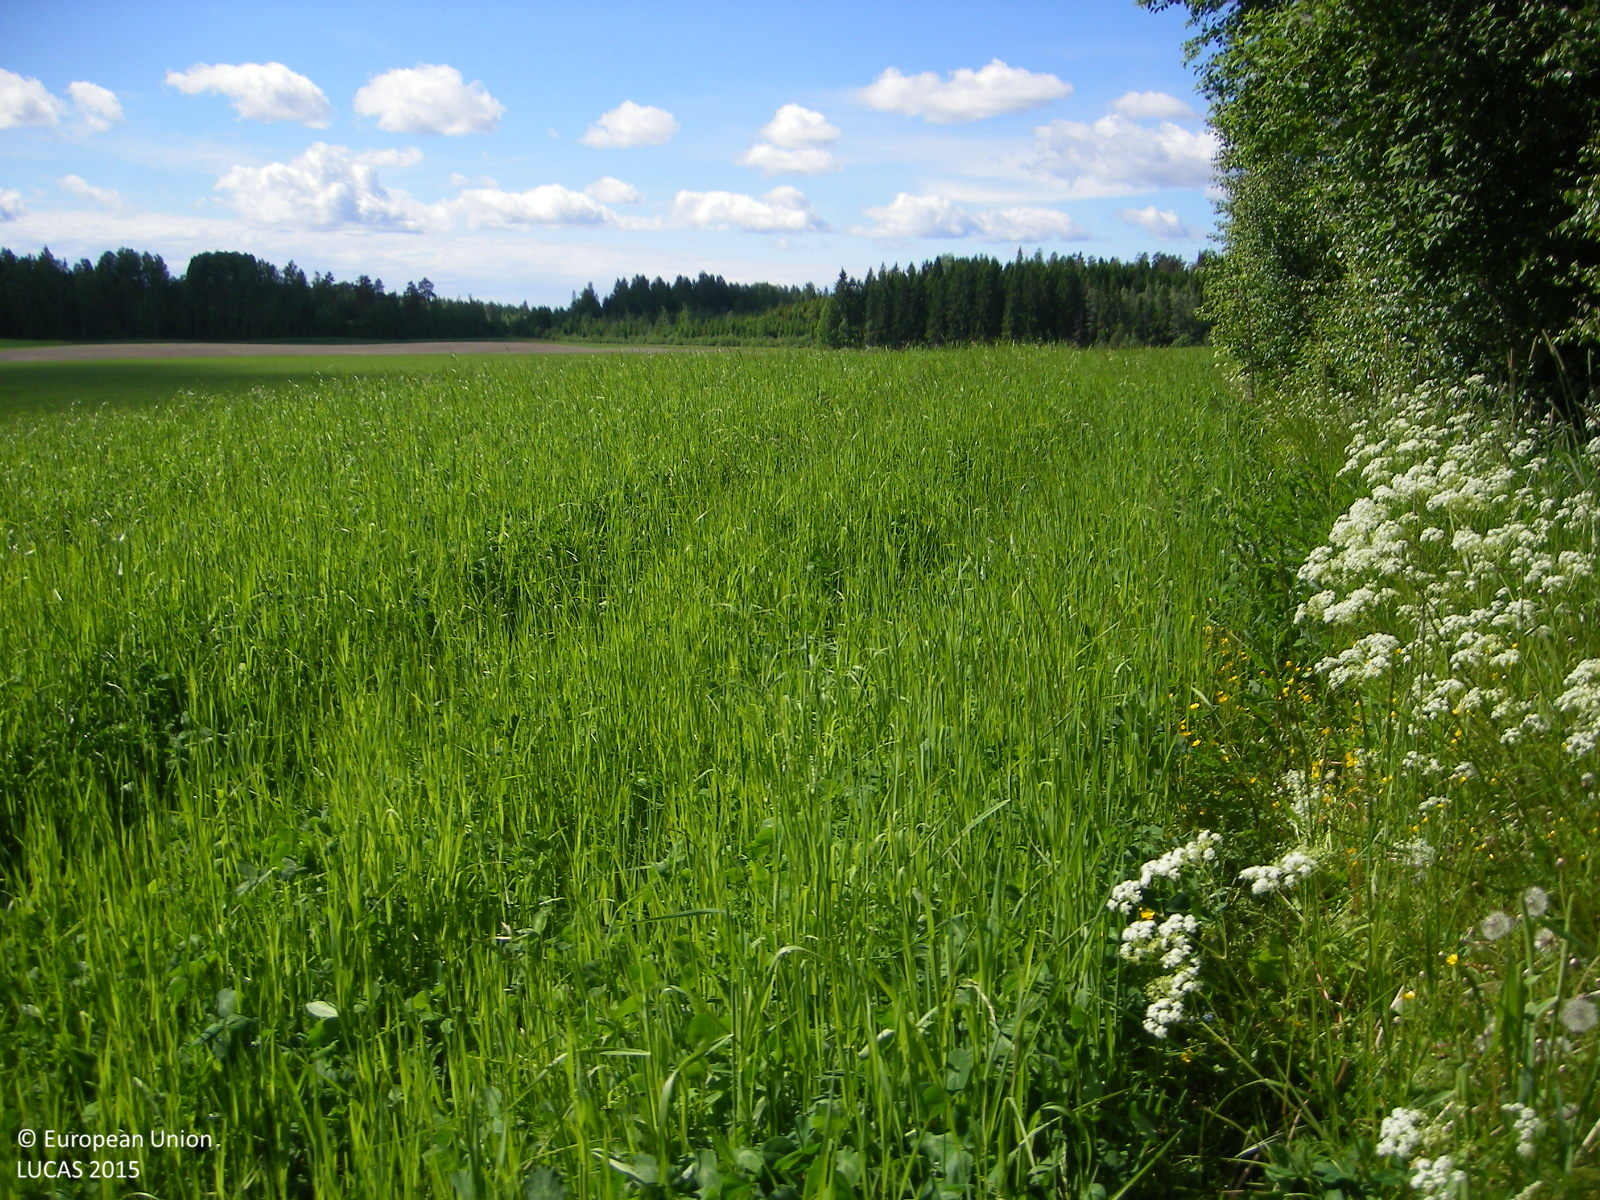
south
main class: Cropland
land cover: Other leguminous and mixtures for fodder
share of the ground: > 75 %
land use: Agriculture (excluding fallow land and kitchen gardens)
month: June
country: FI
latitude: 60.1427
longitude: 24.1292
